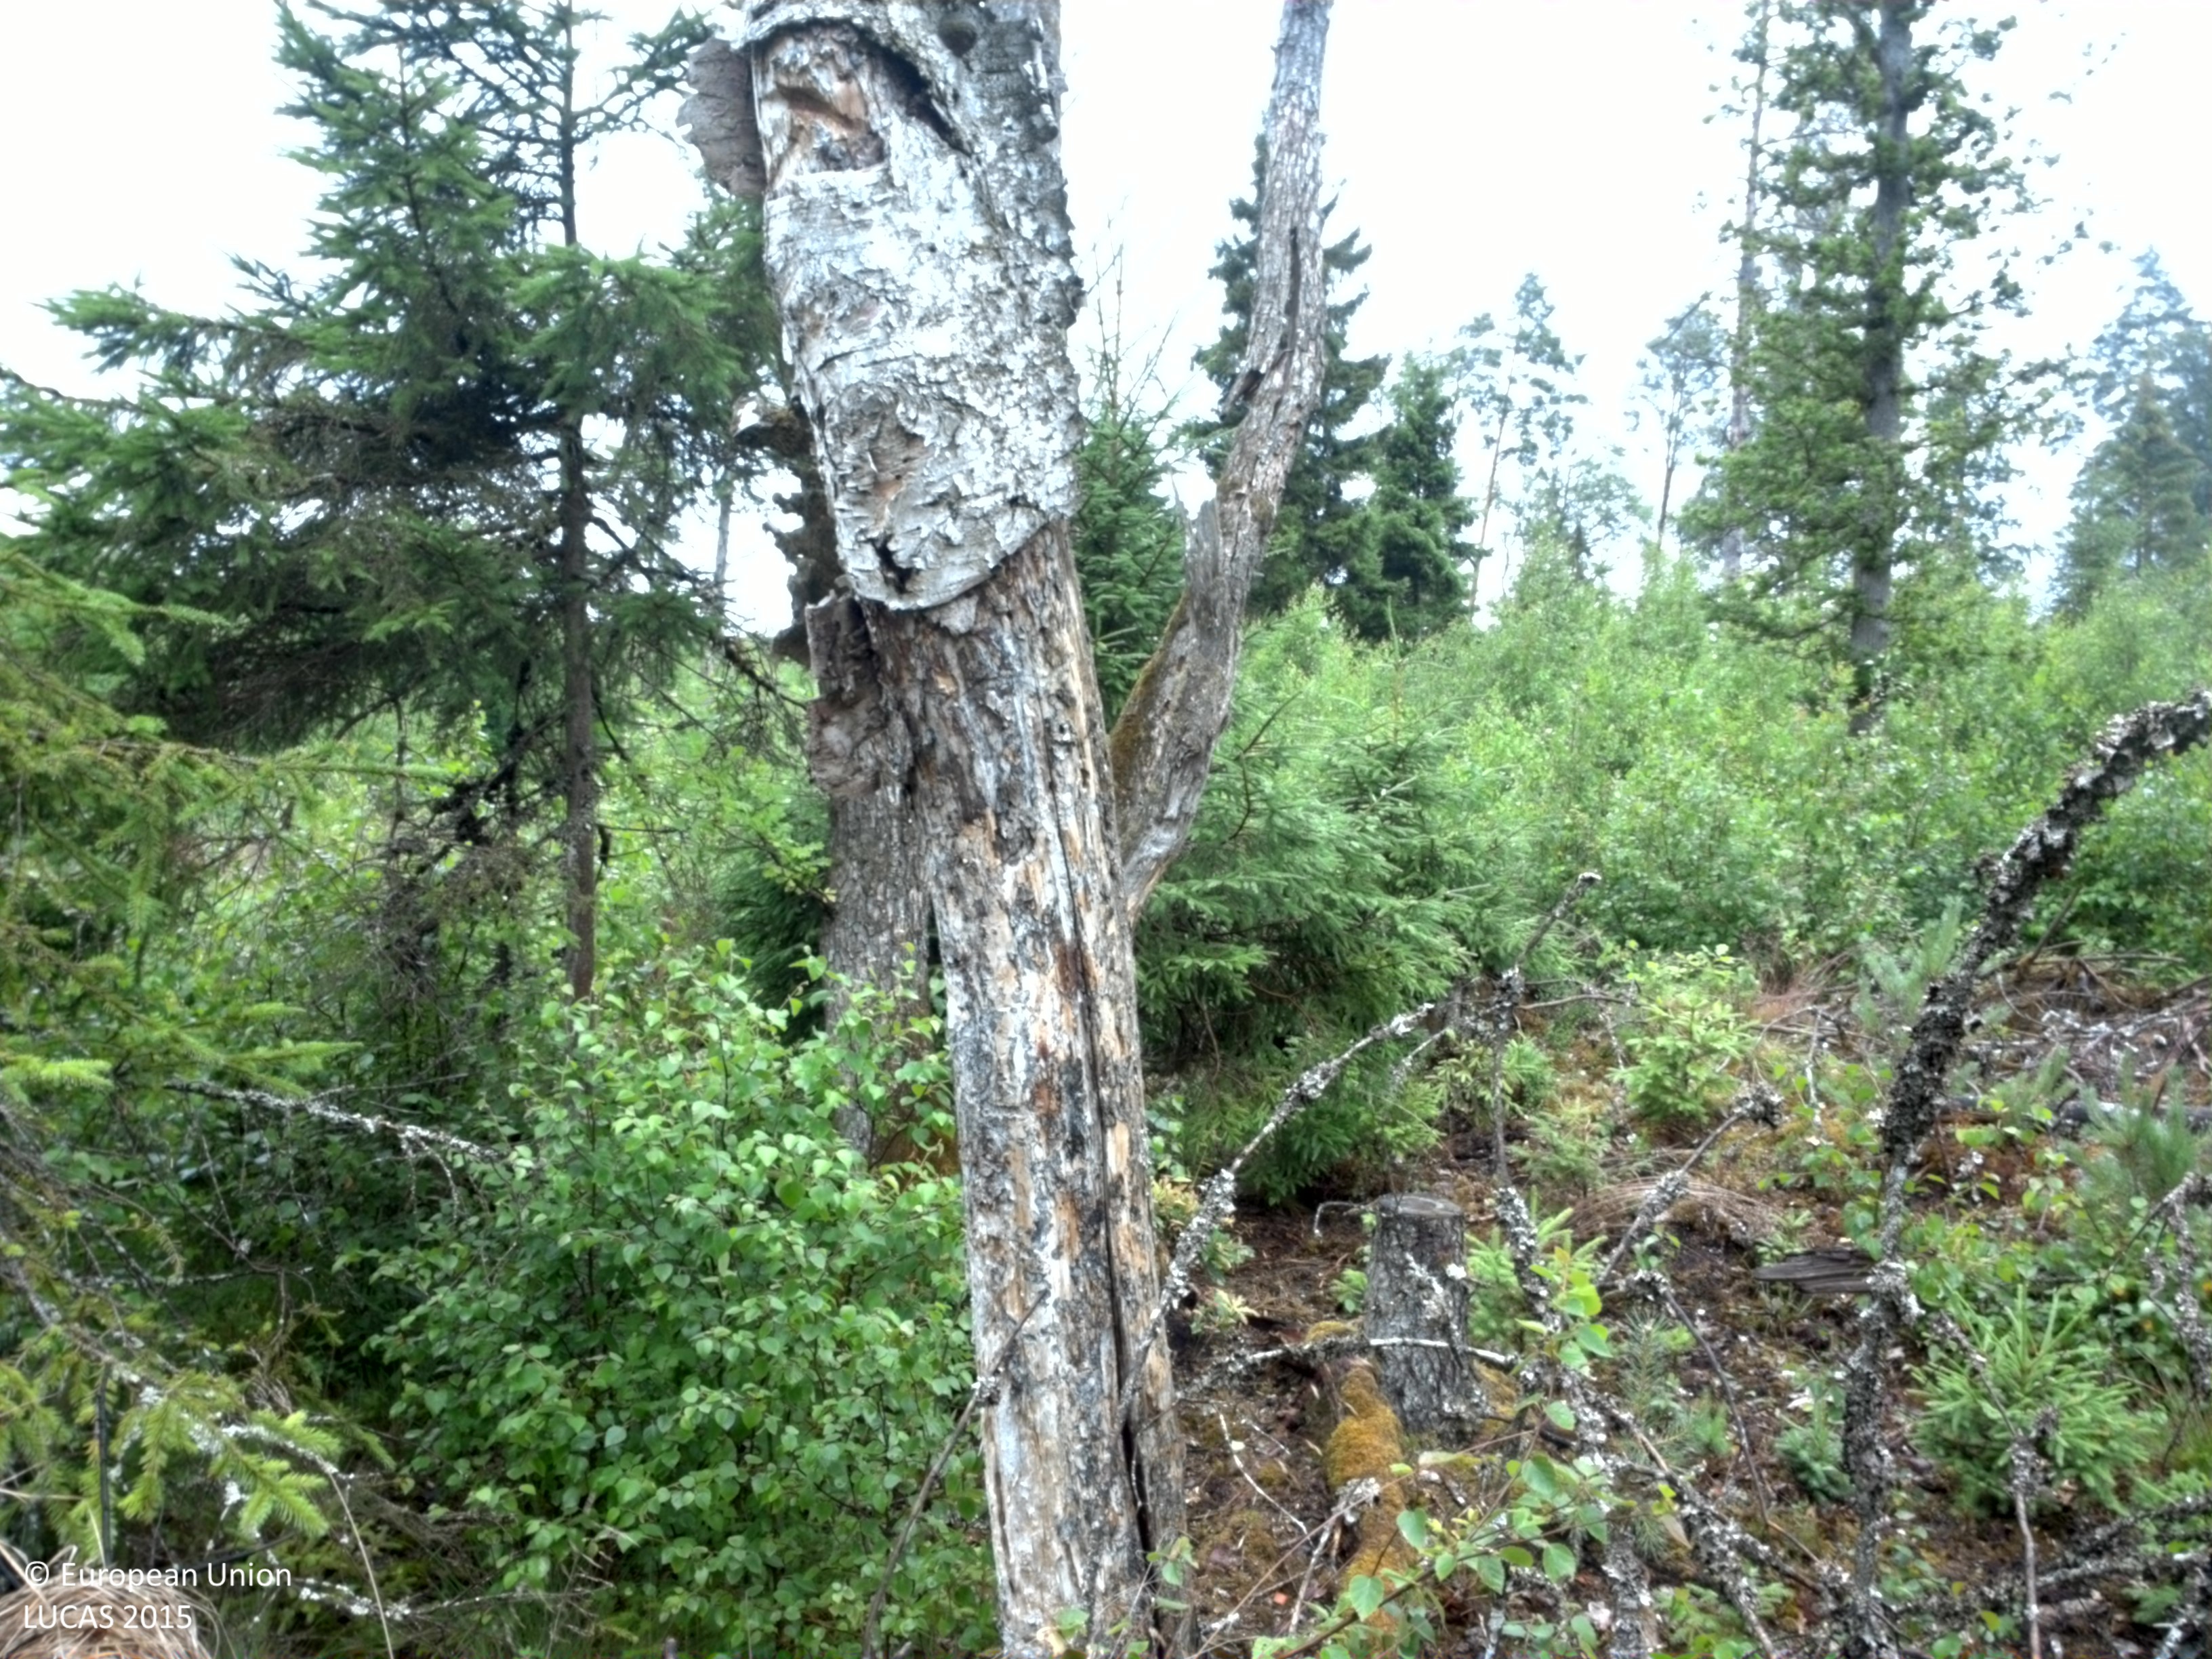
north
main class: Woodland
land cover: Broadleaved woodland
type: hemiboreal forest and nemoral coniferous forest and mixed broadleaved-coniferous forest
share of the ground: > 75 %
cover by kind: broadleaved forest trees 90 %, herbaceous plants 10 %
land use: Forestry
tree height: > 5 m
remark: Clear cut
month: July
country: SE
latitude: 58.3037
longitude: 13.3559
